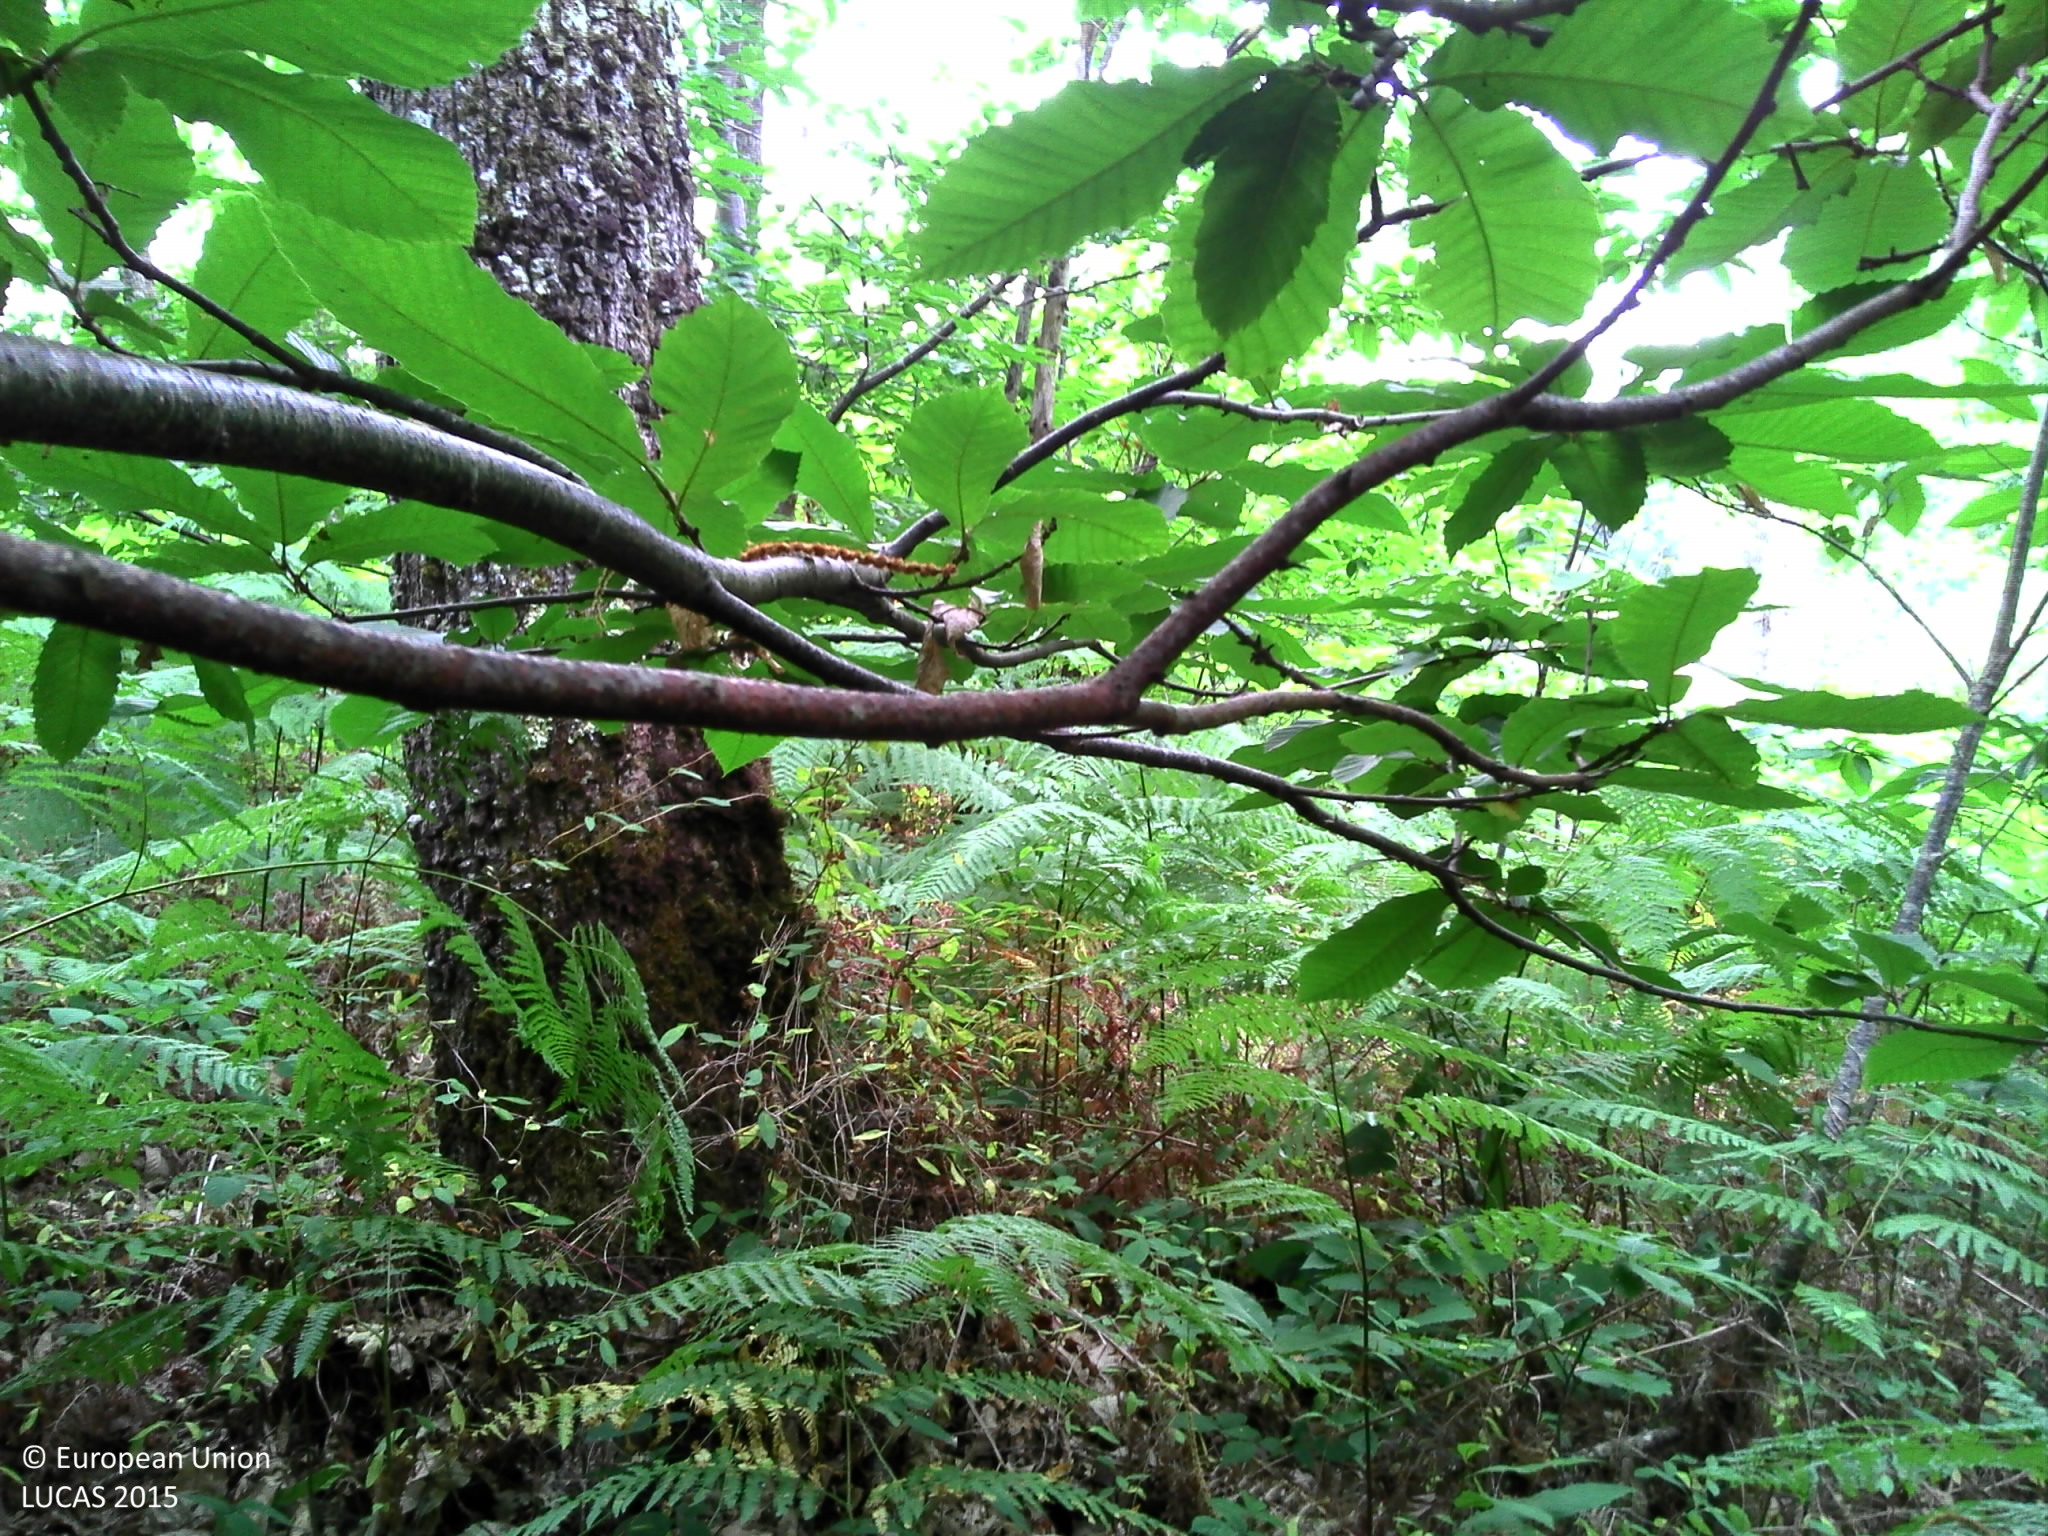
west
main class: Woodland
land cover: Broadleaved woodland
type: thermophilous deciduous forest
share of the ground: > 75 %
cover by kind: broadleaved forest trees 80 %, herbaceous plants 15 %, shrubs 5 %
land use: Forestry
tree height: > 5 m
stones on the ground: 10 - 25 %
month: July
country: FR
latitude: 45.0978
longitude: 0.7525
